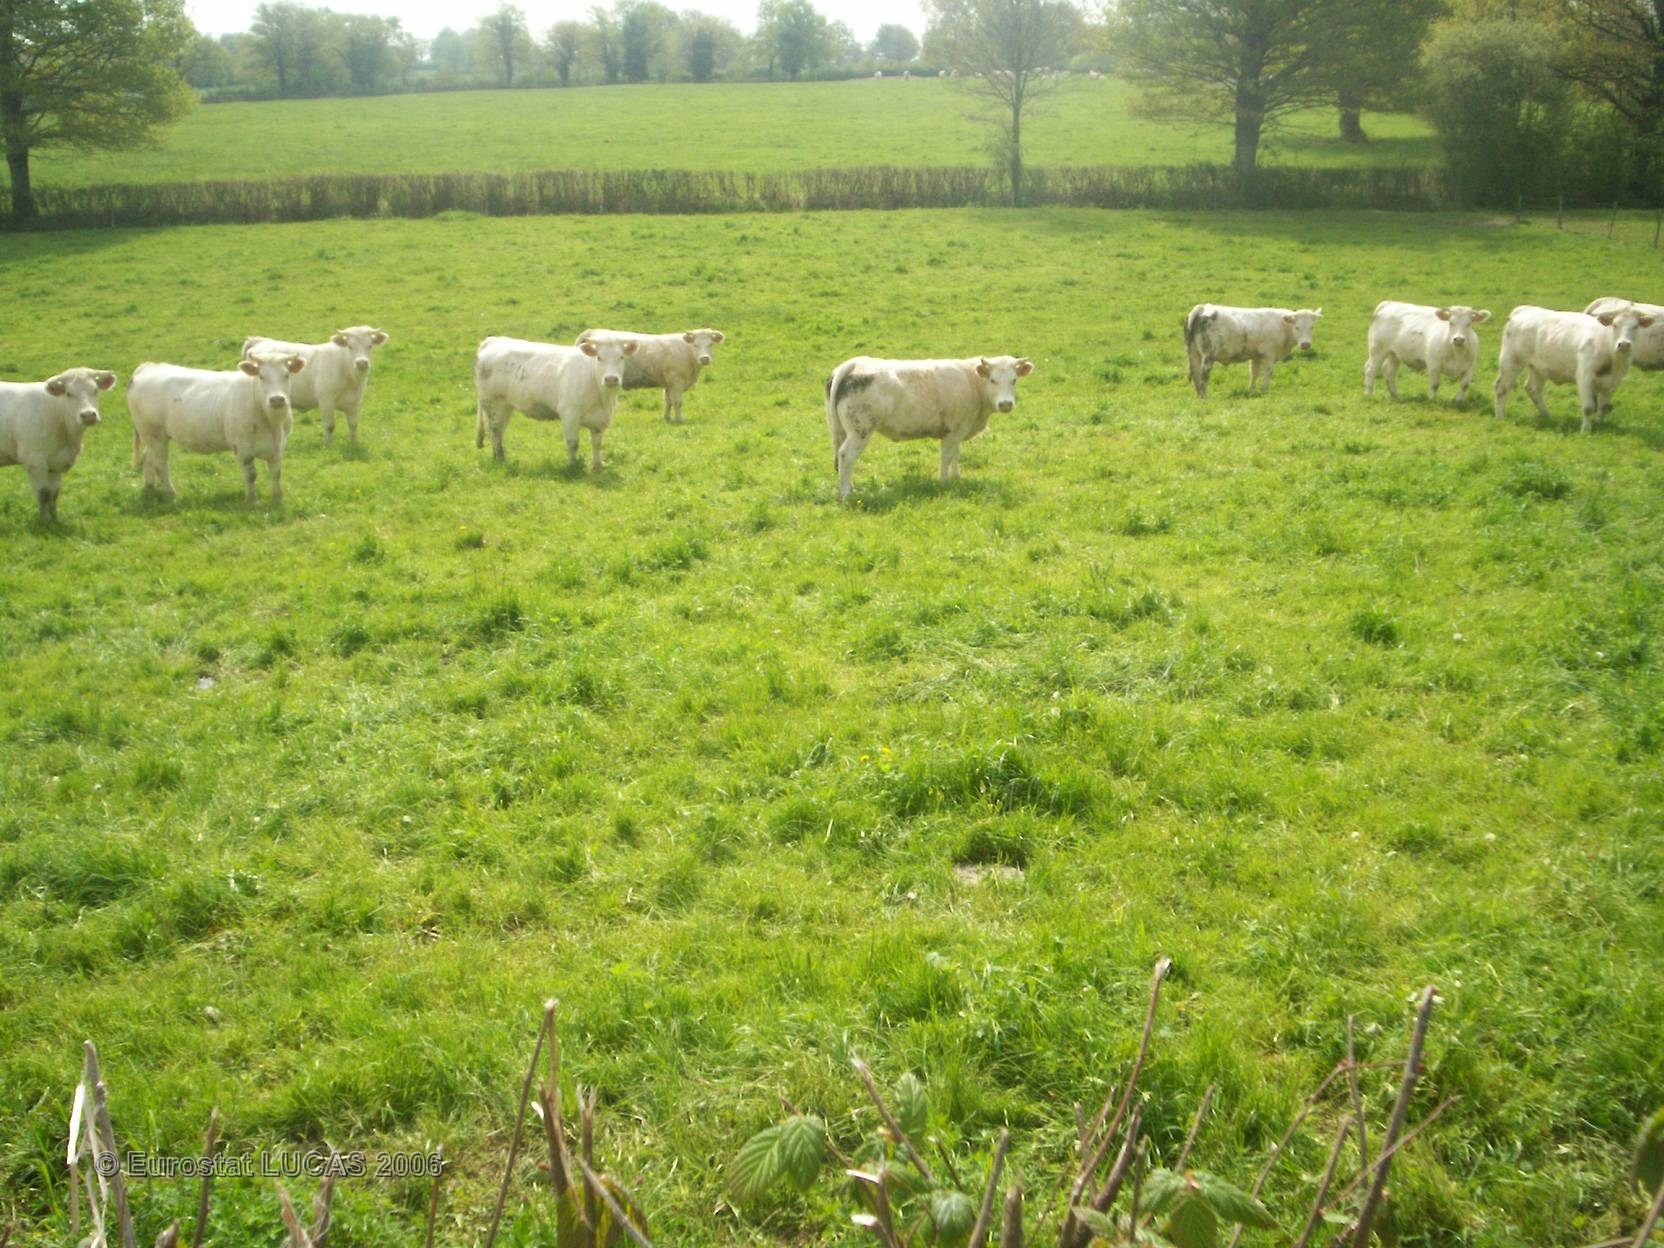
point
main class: Grassland
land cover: Grassland without tree/shrub cover
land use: Agriculture (excluding fallow land and kitchen gardens)
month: May
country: FR
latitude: 46.5635
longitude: 3.1225
